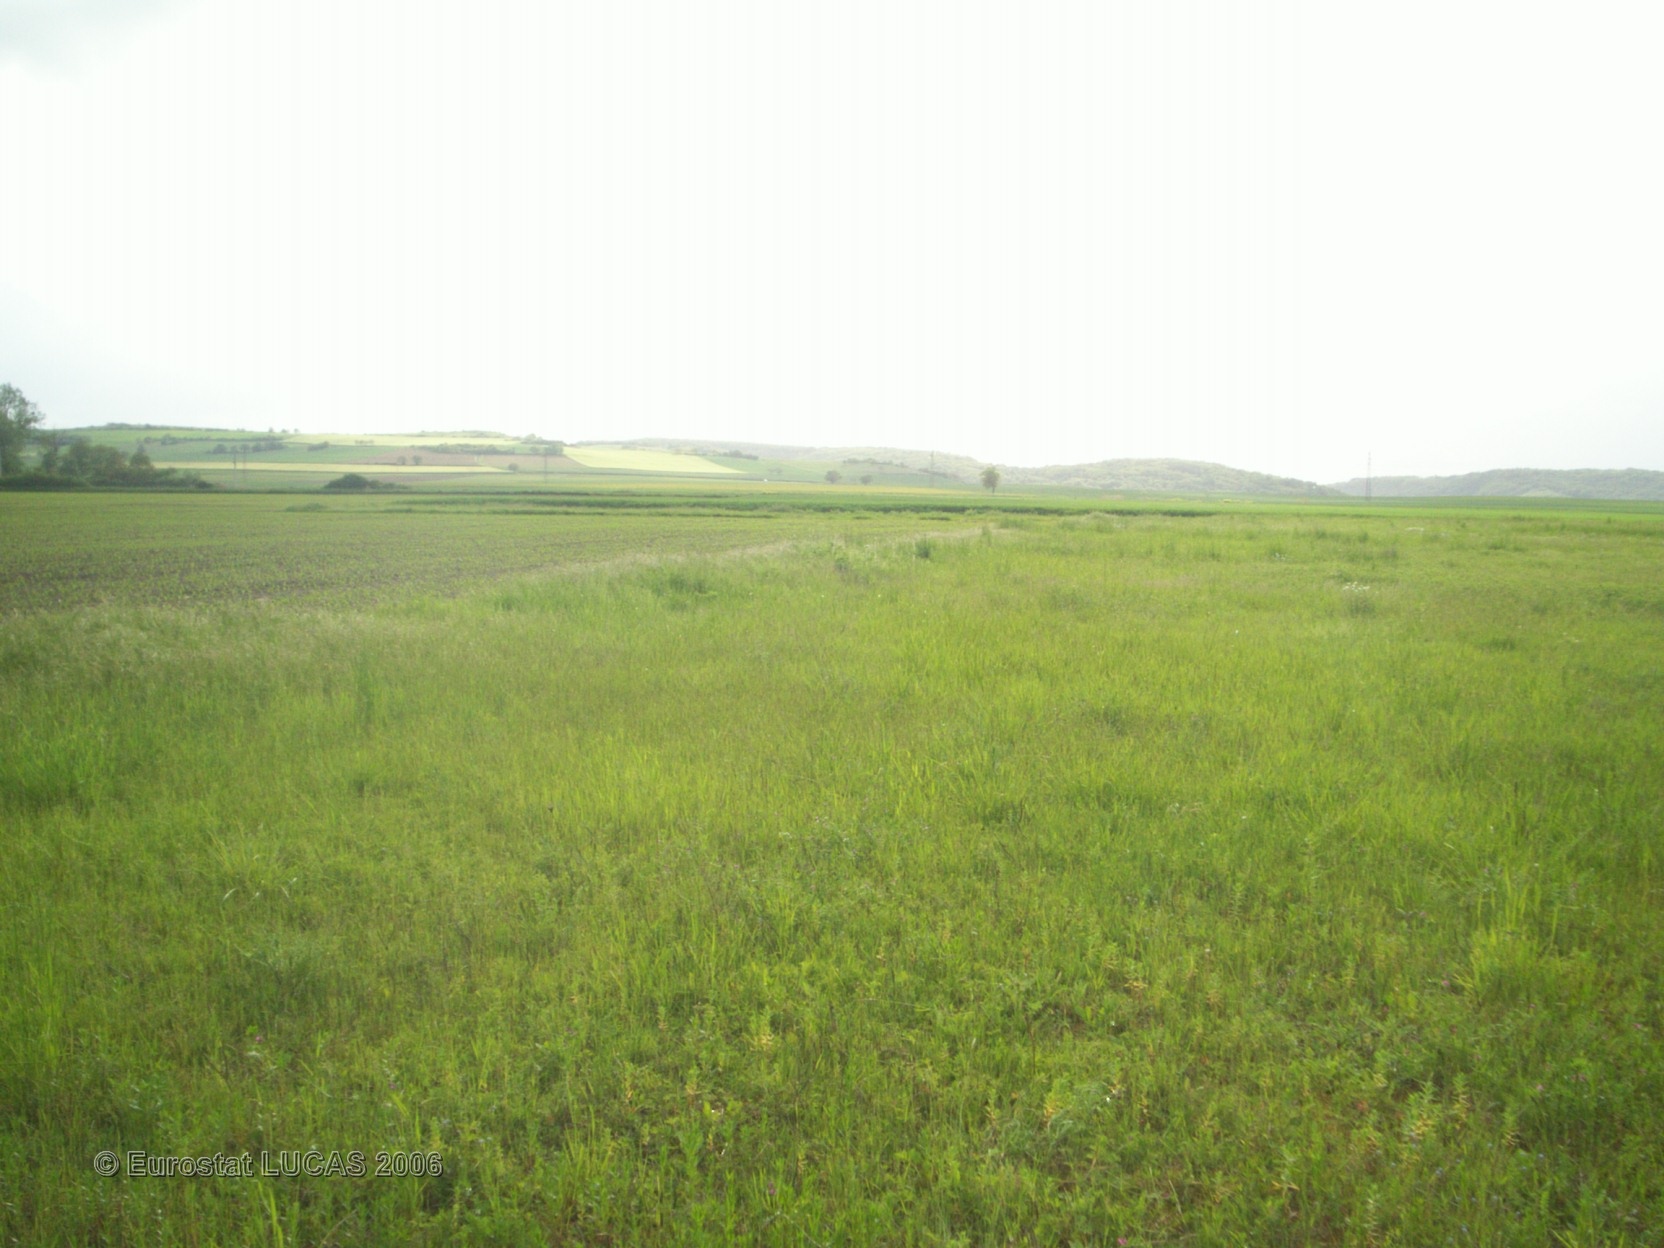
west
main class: Grassland
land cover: Grassland without tree/shrub cover
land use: Agriculture (excluding fallow land and kitchen gardens)
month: May
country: FR
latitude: 46.1545
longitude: 3.2269
